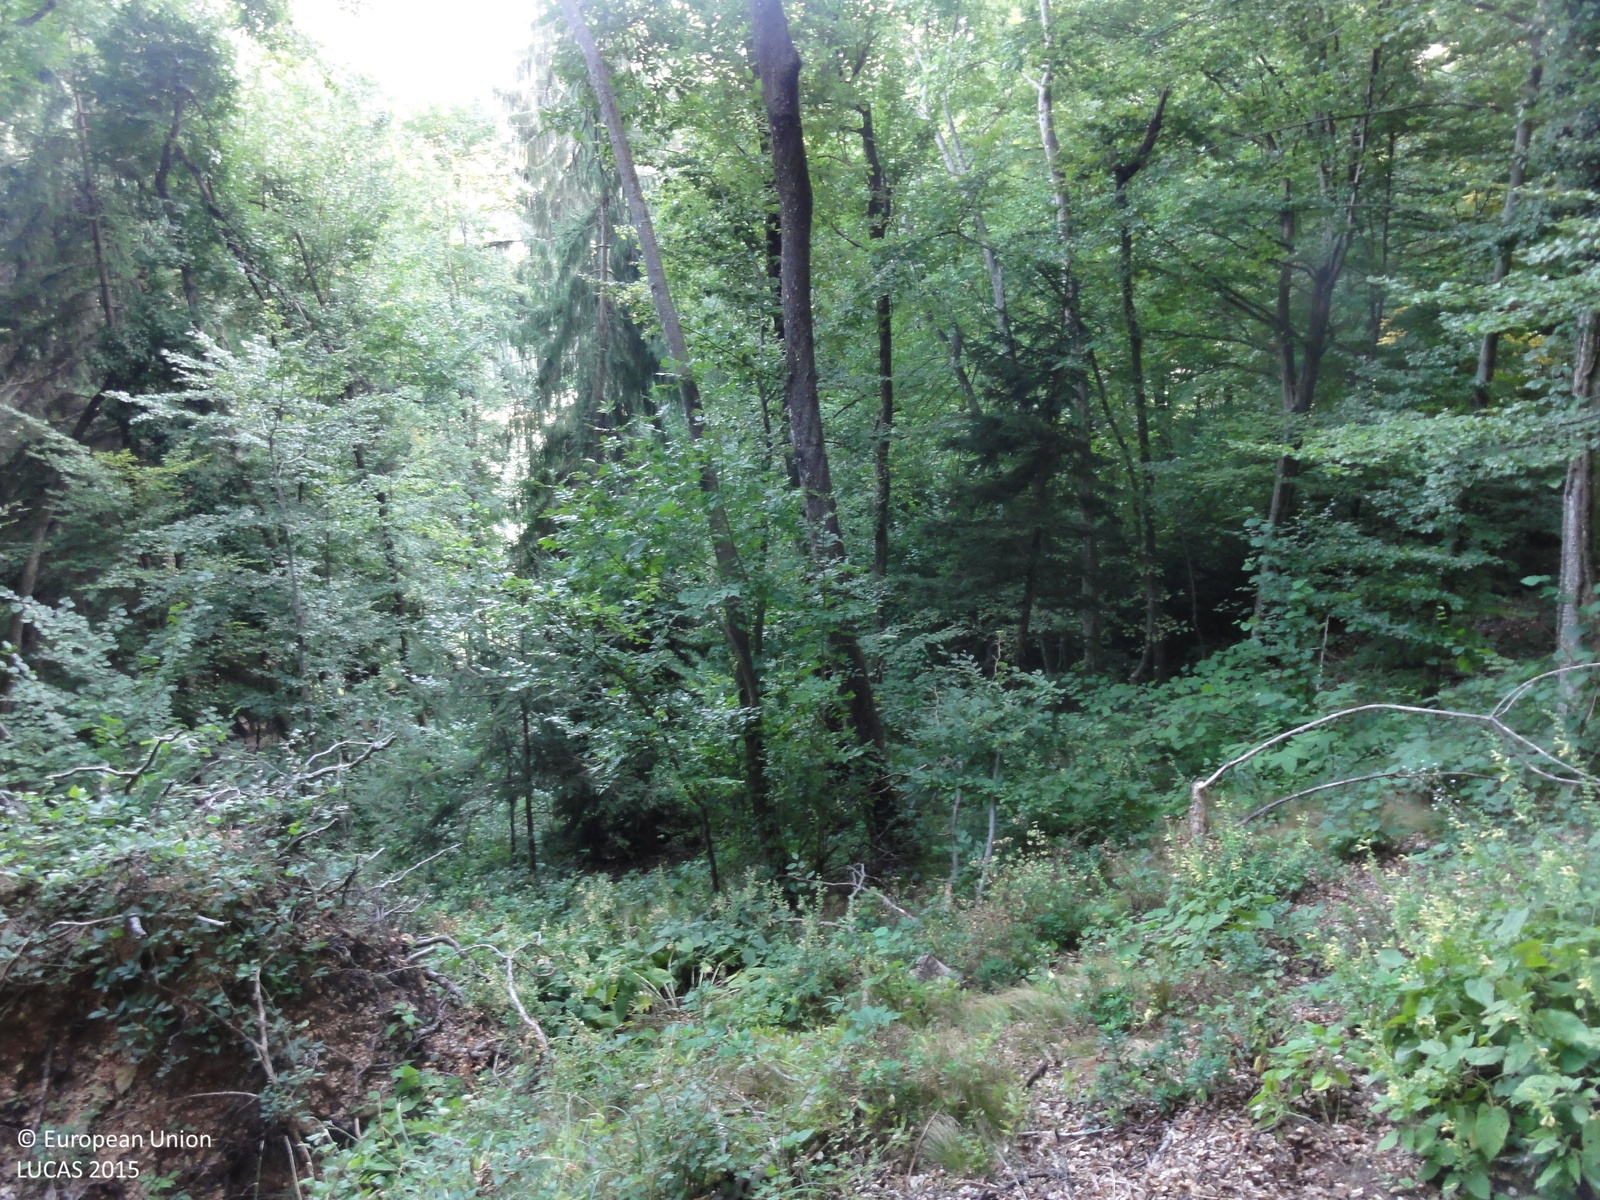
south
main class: Woodland
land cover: Broadleaved woodland
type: beech forest
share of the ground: > 75 %
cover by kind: broadleaved forest trees 90 %, coniferous forest trees 10 %
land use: Forestry
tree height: > 5 m
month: August
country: SI
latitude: 46.0682
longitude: 15.0779
